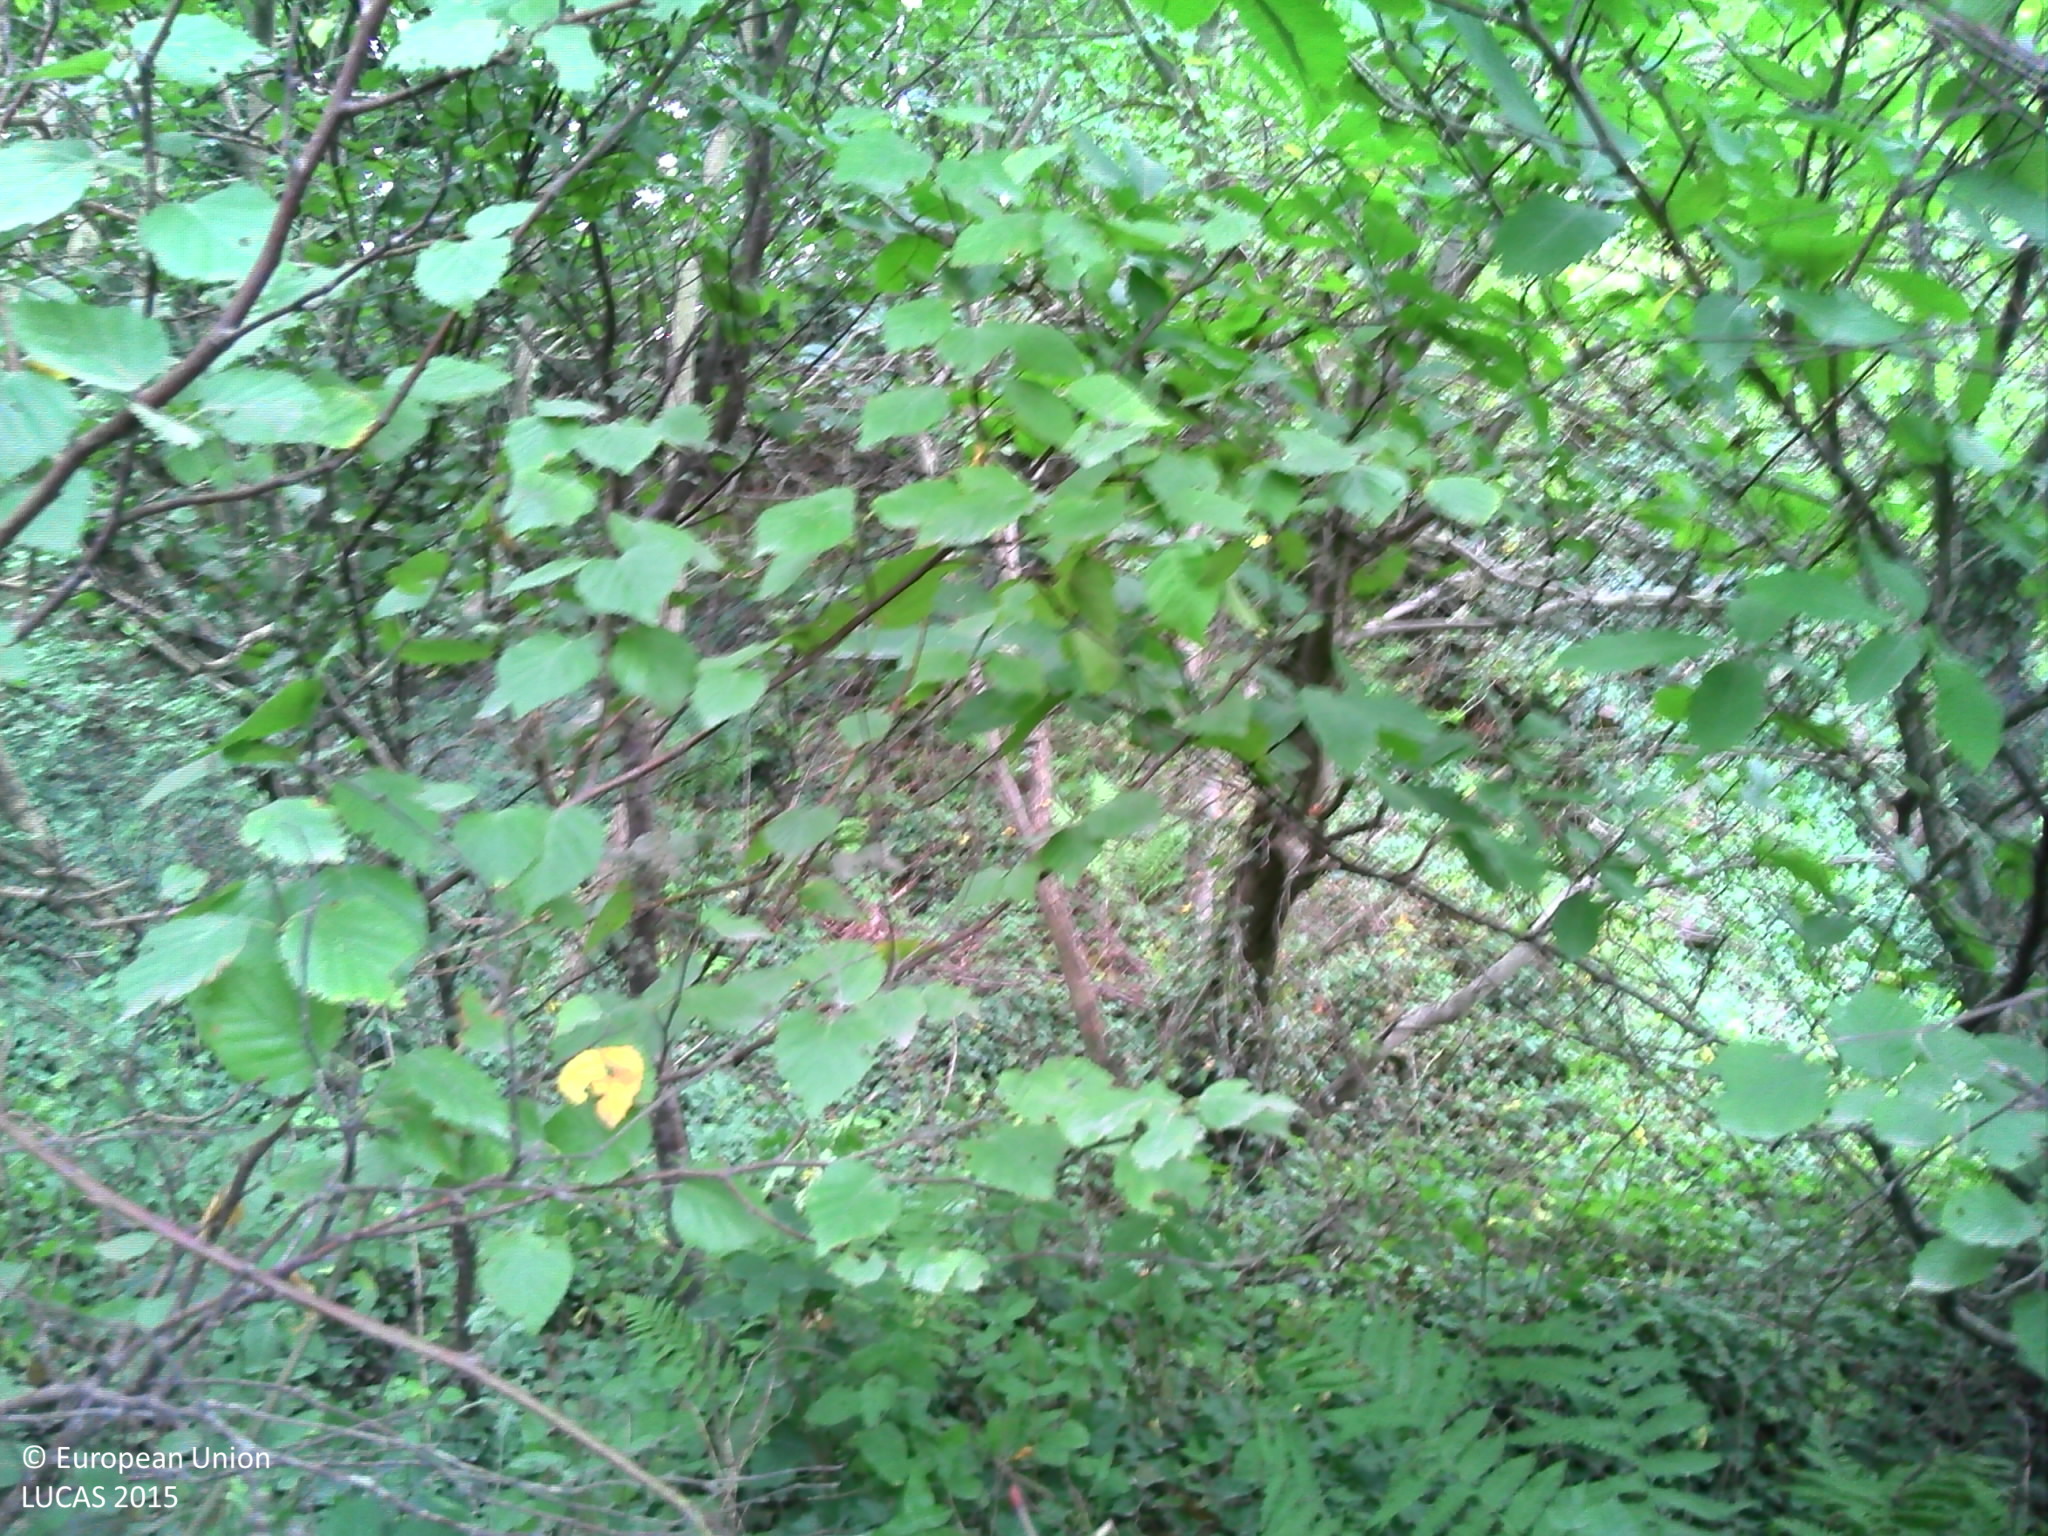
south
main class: Shrubland
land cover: Shrubland without tree cover
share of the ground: > 75 %
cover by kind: shrubs 50 %, herbaceous plants 50 %
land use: Semi-natural and natural areas not in use
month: August
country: FR
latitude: 48.6906
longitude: -1.3344
